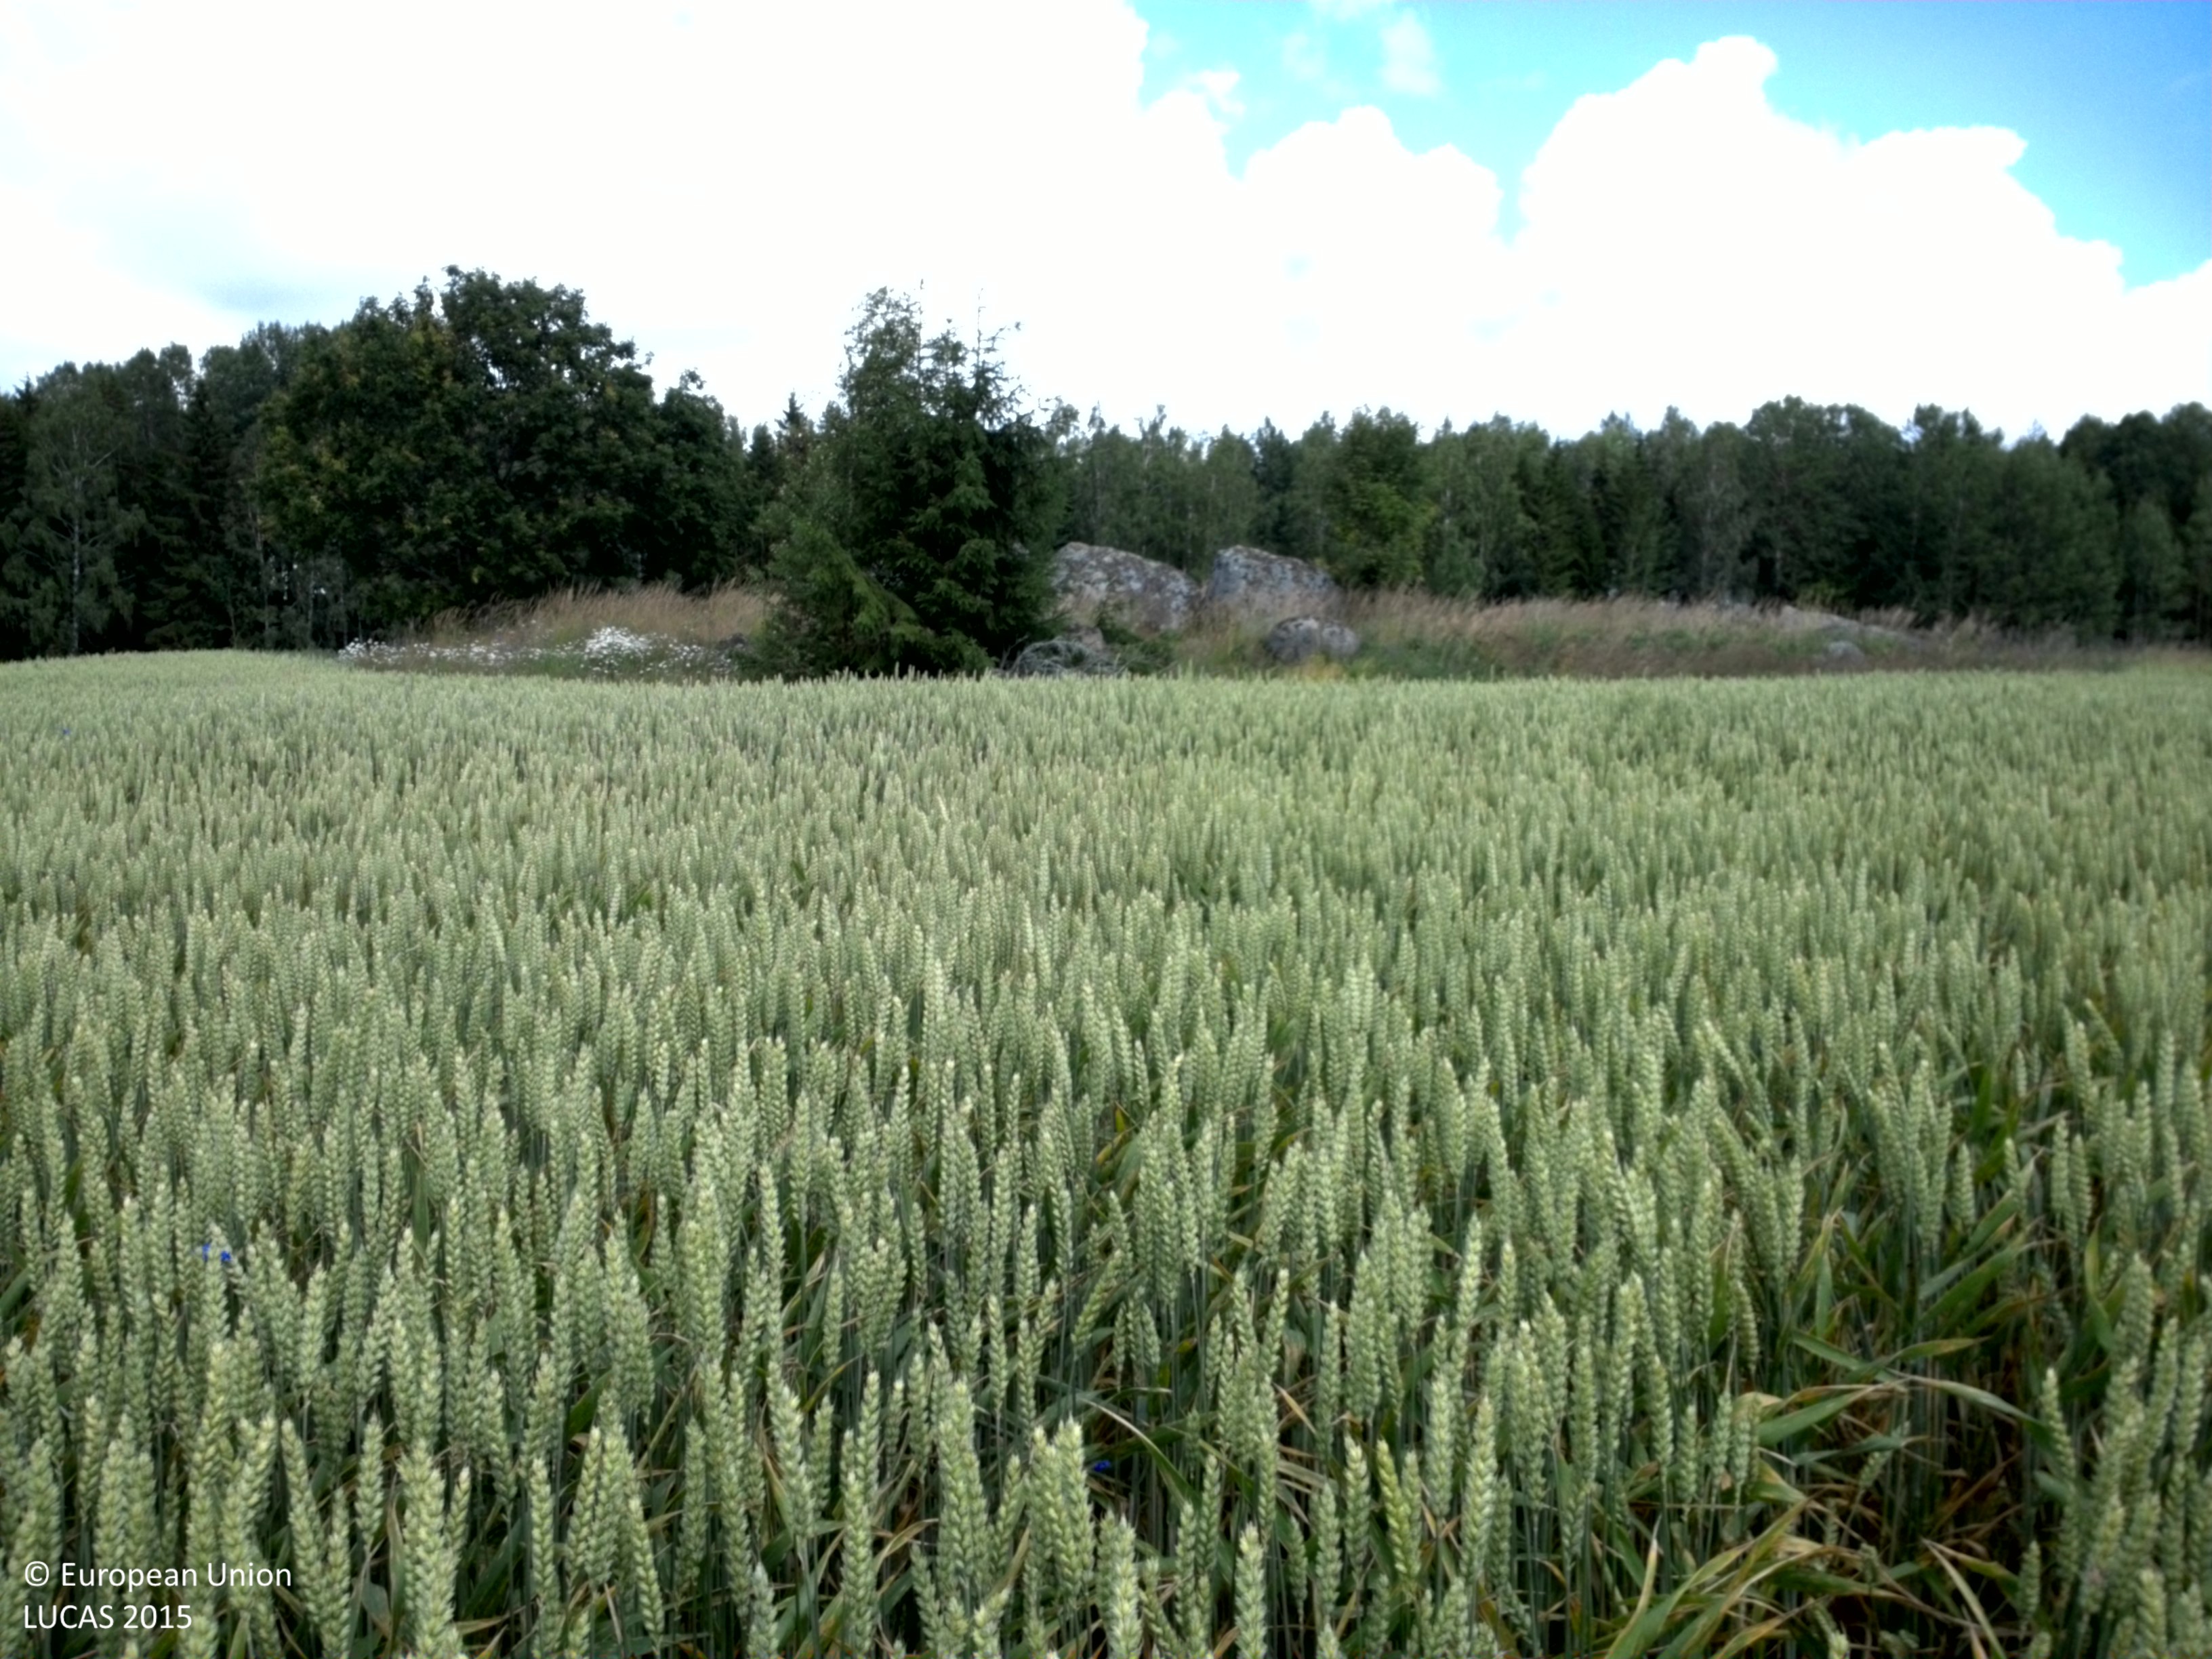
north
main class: Cropland
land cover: Common wheat
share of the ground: > 75 %
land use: Agriculture (excluding fallow land and kitchen gardens)
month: July
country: SE
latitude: 58.7339
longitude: 15.6077
